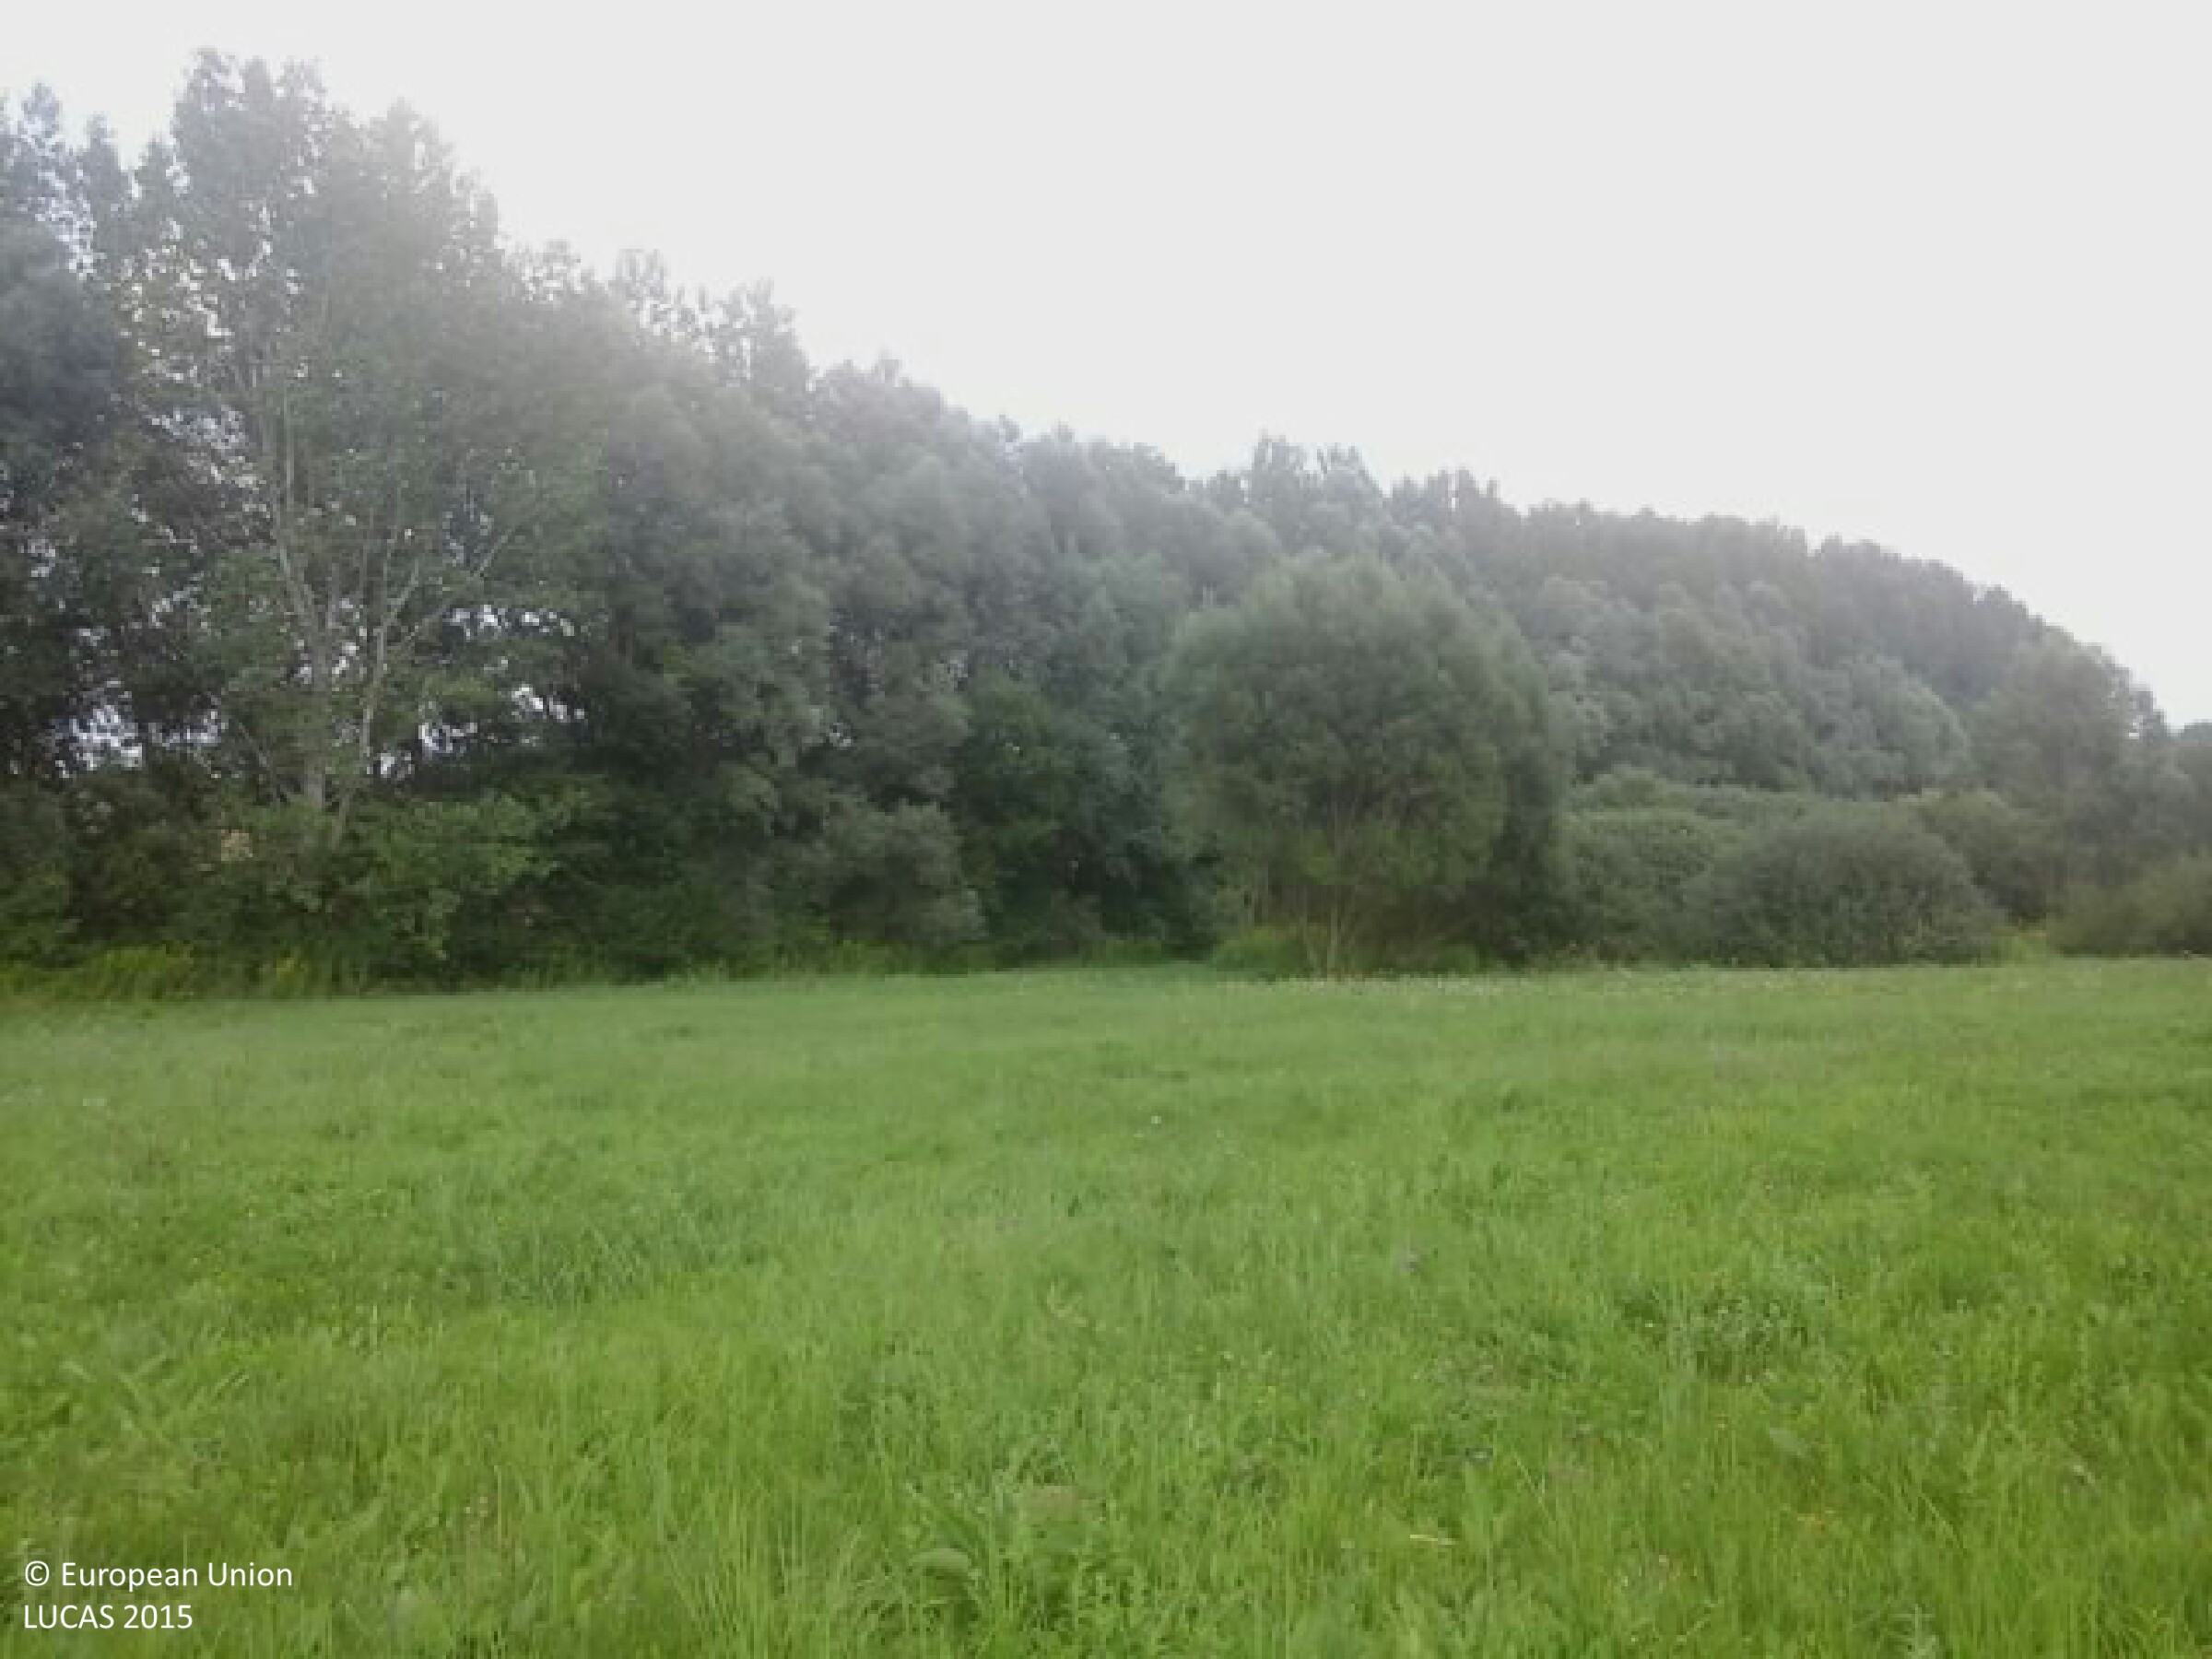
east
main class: Grassland
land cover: Grassland without tree/shrub cover
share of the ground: > 75 %
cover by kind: herbaceous plants 100 %
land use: Agriculture (excluding fallow land and kitchen gardens)
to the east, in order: Grassland without tree/shrub cover; Abandoned hedges; Ditches and canals; Broadleaved woodland; Tracks; Triticale; Maize; Grassland without tree/shrub cover; Artificial constructions in urban areas
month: August
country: HU
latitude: 46.3092
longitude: 18.4103
